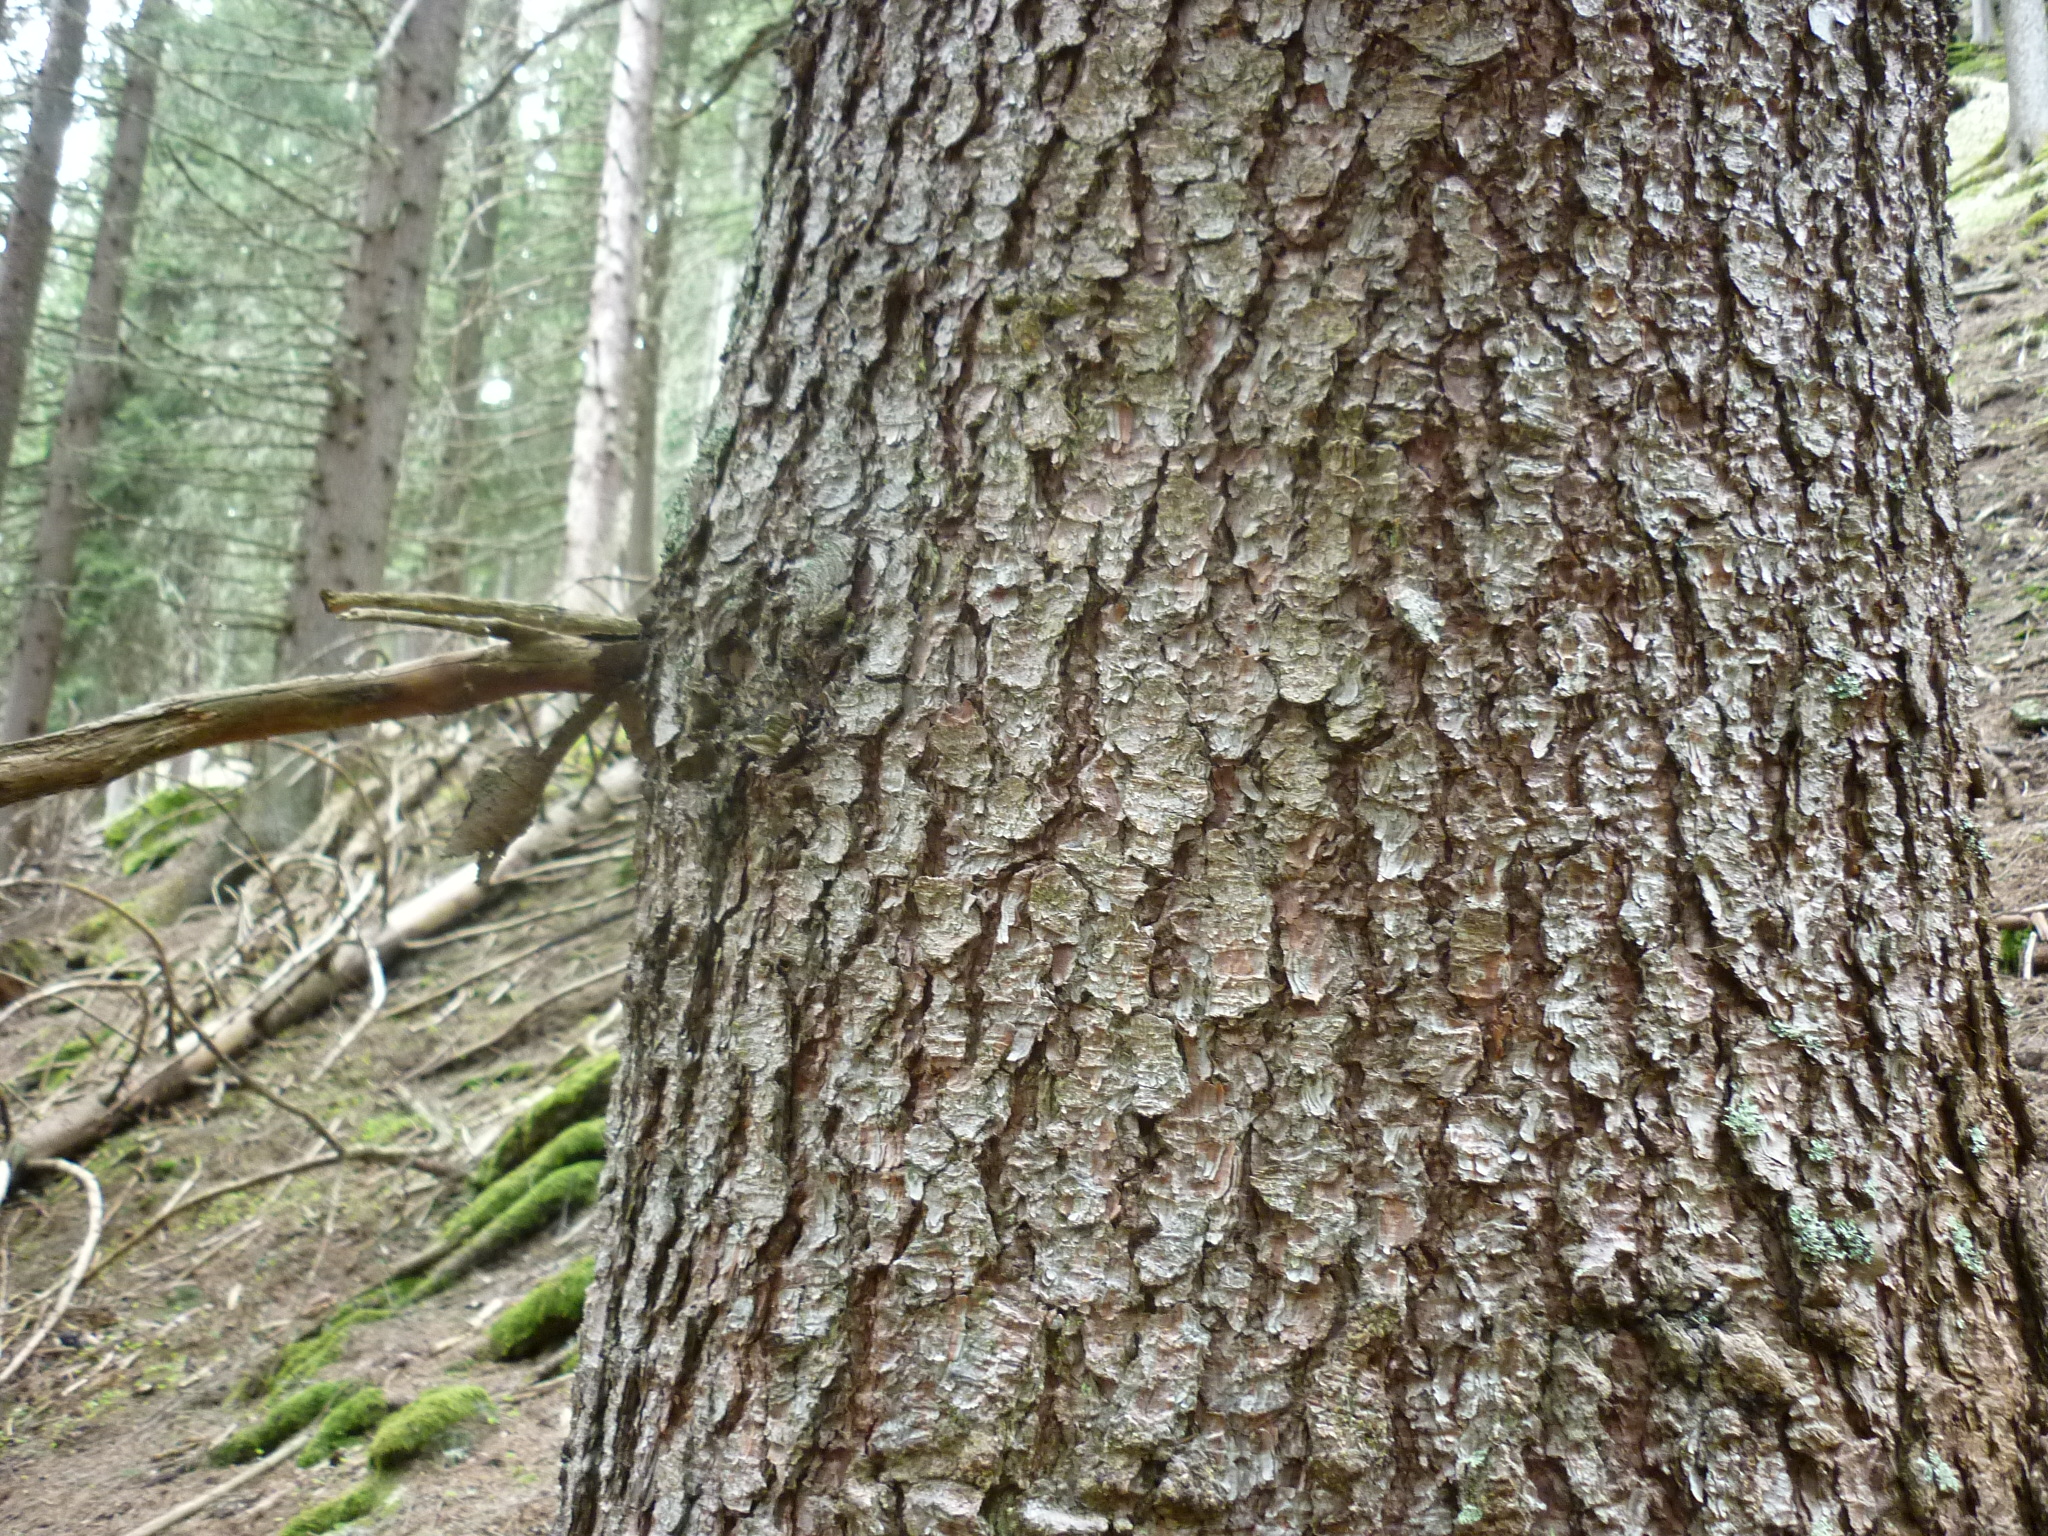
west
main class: Woodland
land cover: Spruce dominated coniferous woodland
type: alpine coniferous forest
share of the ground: > 75 %
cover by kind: coniferous forest trees 90 %, lichens and mosses 5 %, unconsolidated bare surface 5 %
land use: Forestry
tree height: > 5 m
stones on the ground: < 10 %
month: May
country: AT
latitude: 47.4196
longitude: 14.2802
